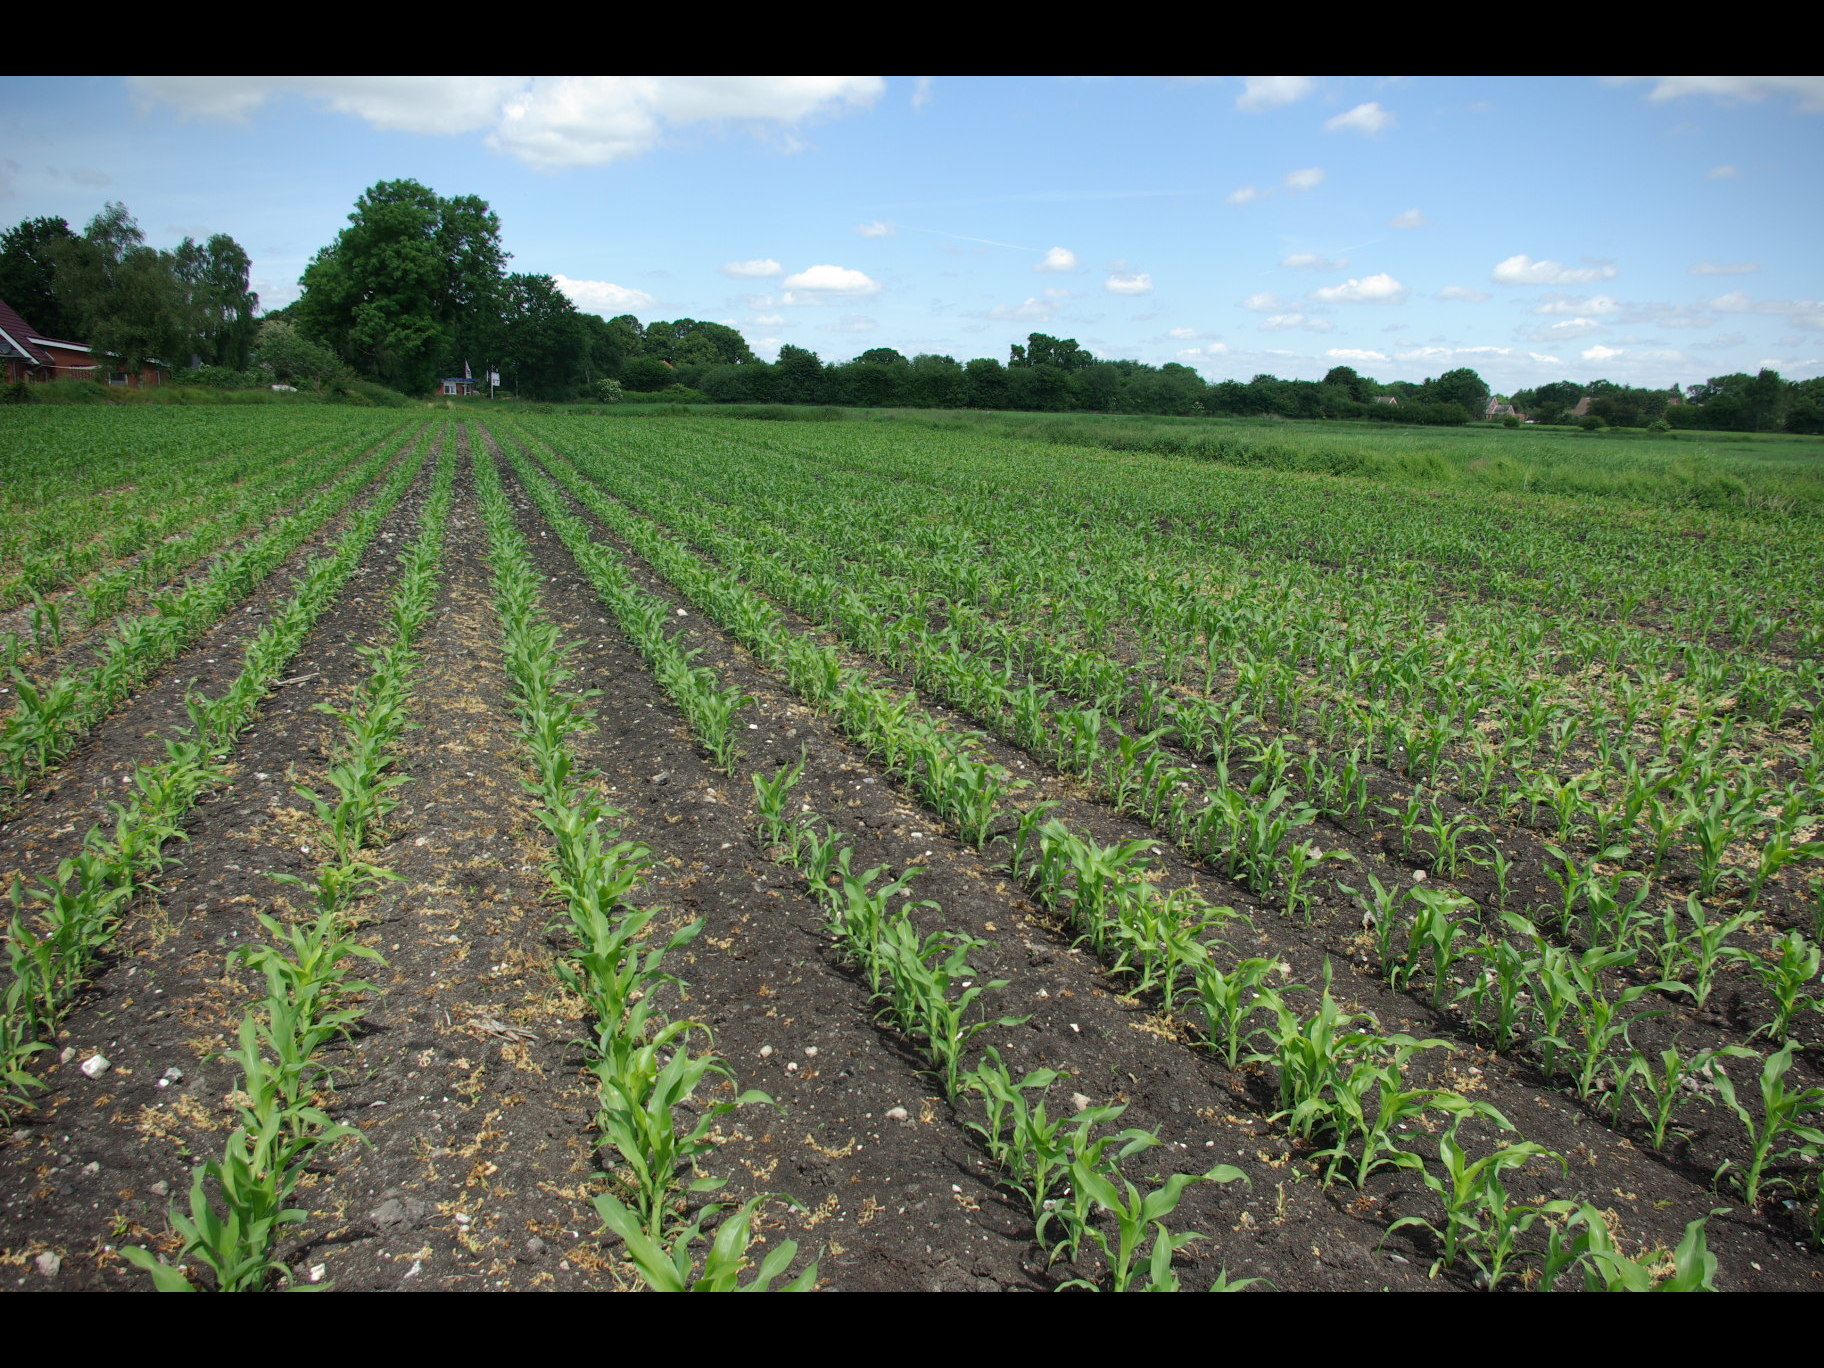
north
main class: Cropland
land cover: Maize
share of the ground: 25 - 50 %
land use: Agriculture (excluding fallow land and kitchen gardens)
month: June
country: DE
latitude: 54.3539
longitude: 9.6463
